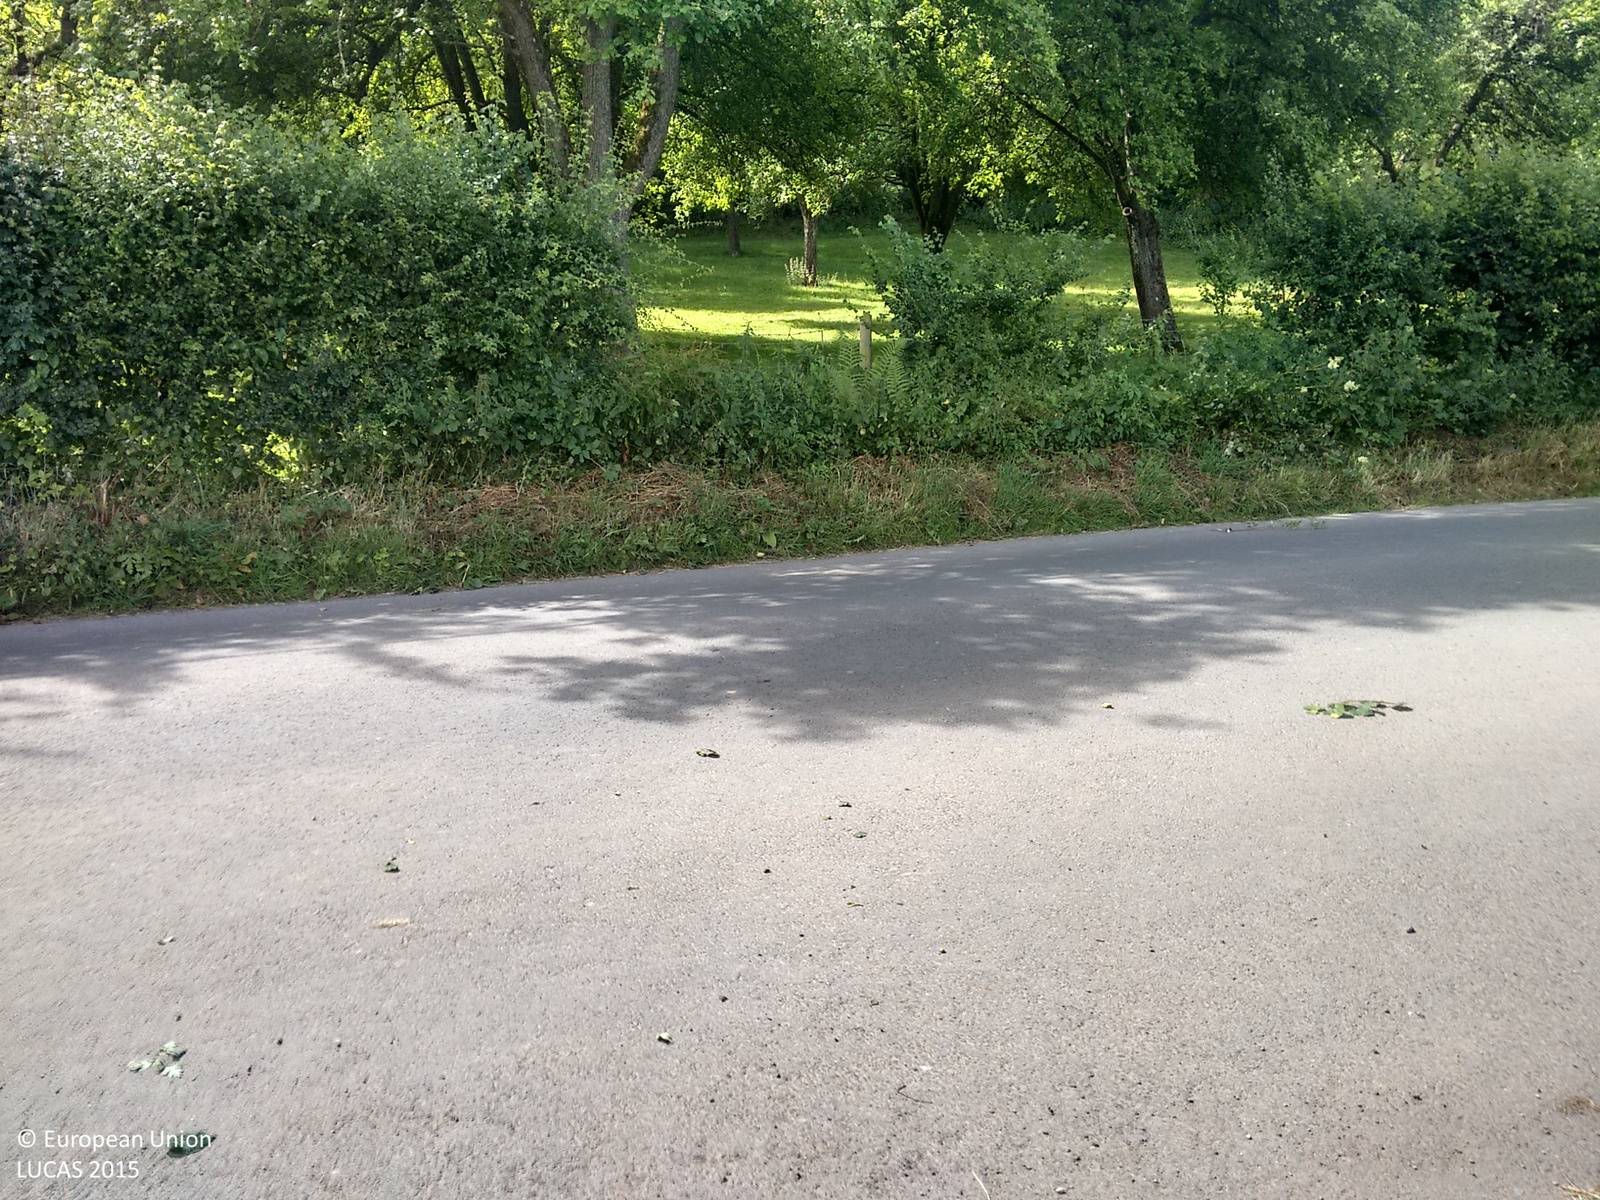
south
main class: Grassland
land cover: Grassland without tree/shrub cover
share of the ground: > 75 %
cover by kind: herbaceous plants 100 %
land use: Agriculture (excluding fallow land and kitchen gardens)
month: July
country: GB
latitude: 52.1491
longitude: -2.6818
